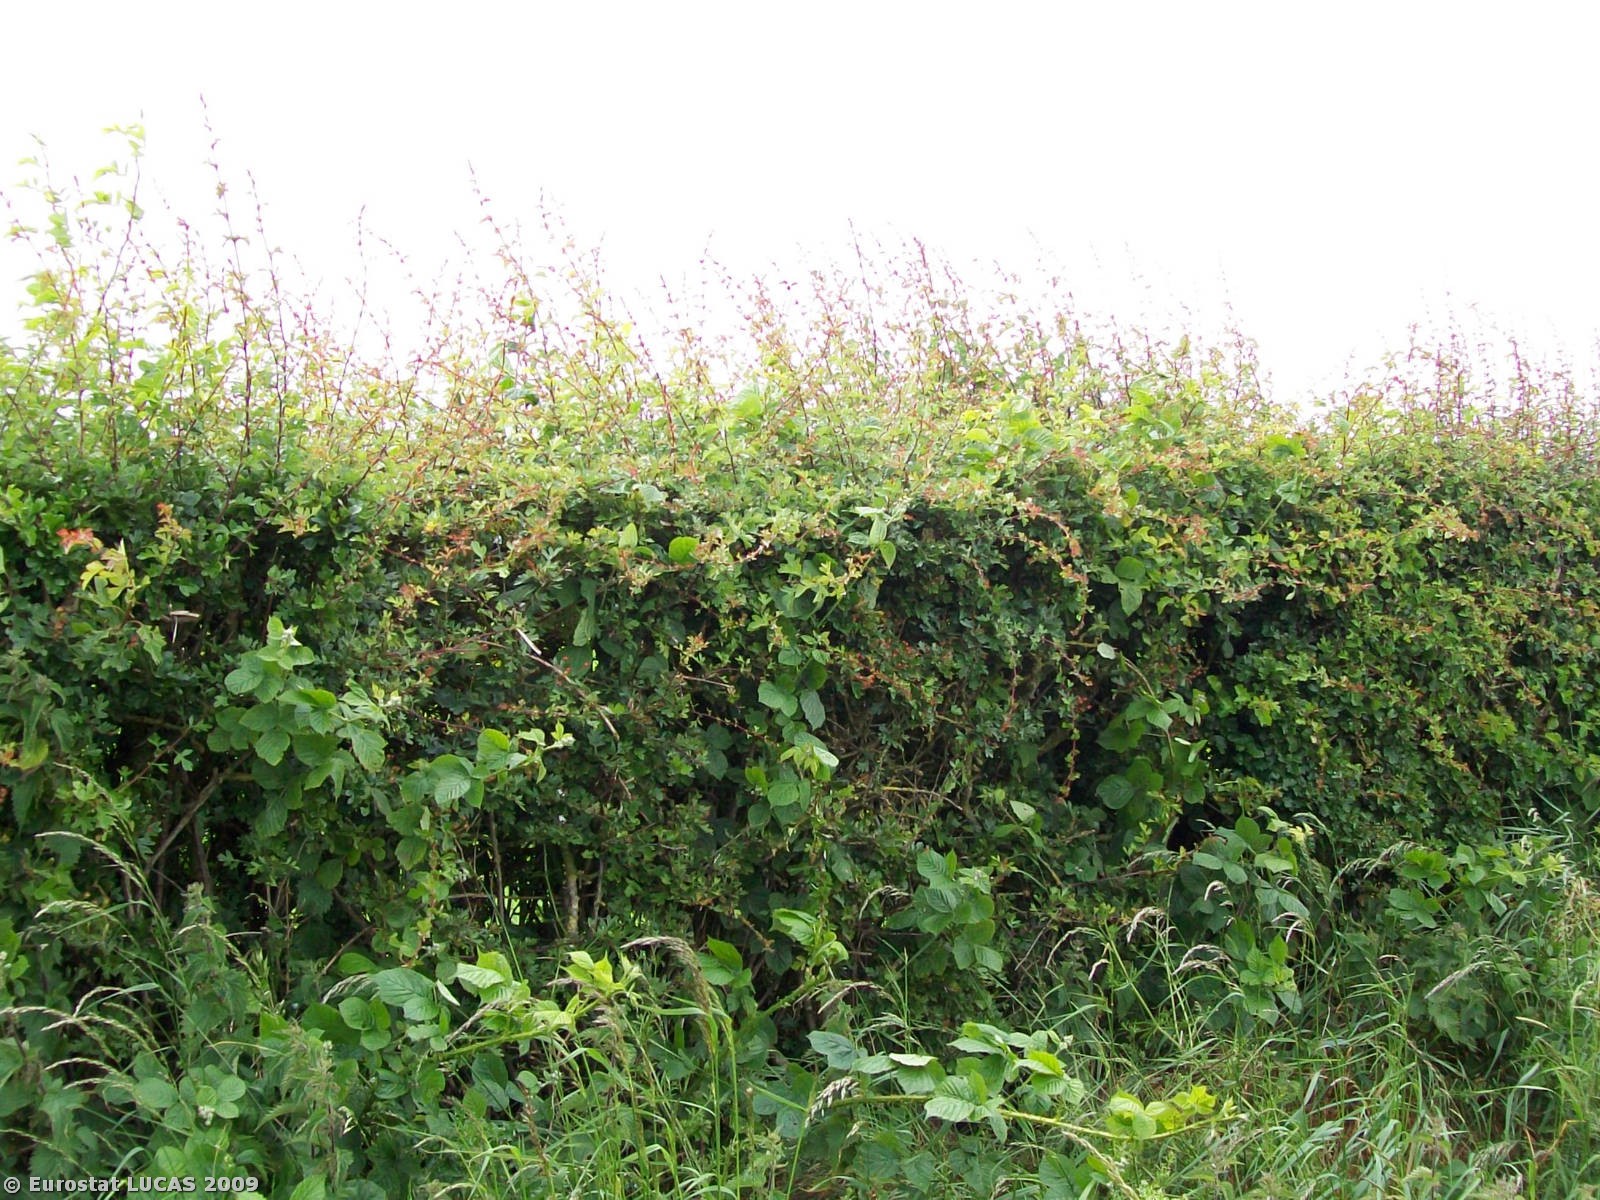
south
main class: Grassland
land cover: Grassland without tree/shrub cover
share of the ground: > 75 %
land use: Road transport
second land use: Unused
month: June
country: GB
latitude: 54.8976
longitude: -3.2207
